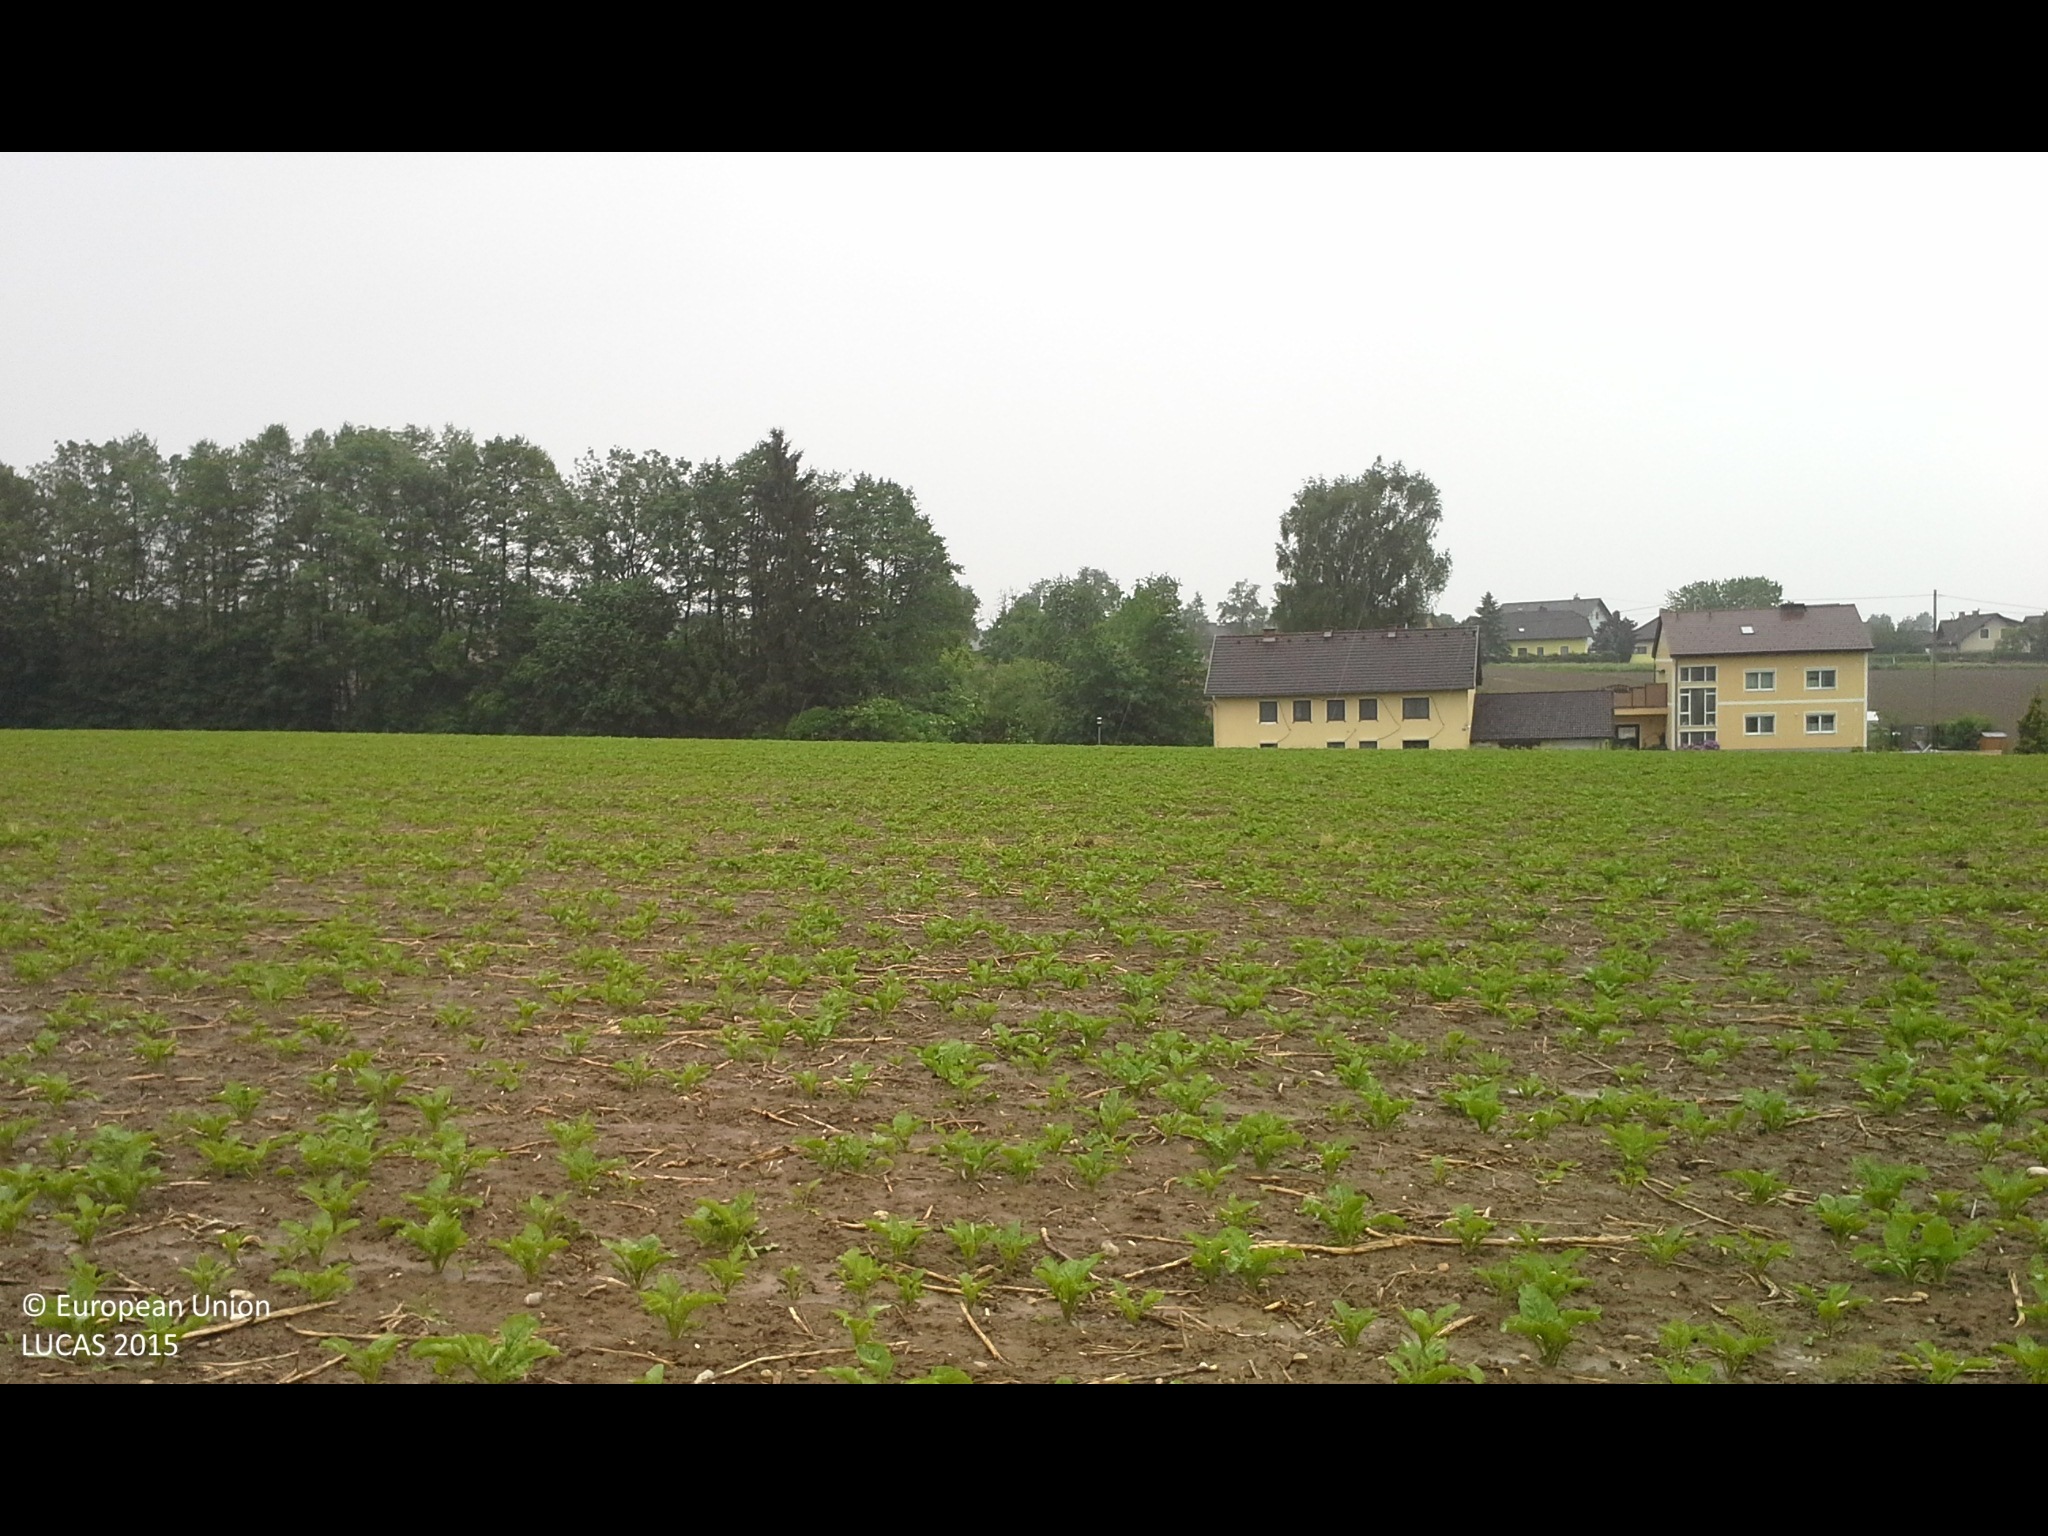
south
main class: Cropland
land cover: Sugar beet
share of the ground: 10 - 25 %
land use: Agriculture (excluding fallow land and kitchen gardens)
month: May
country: AT
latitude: 48.1772
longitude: 14.2631
